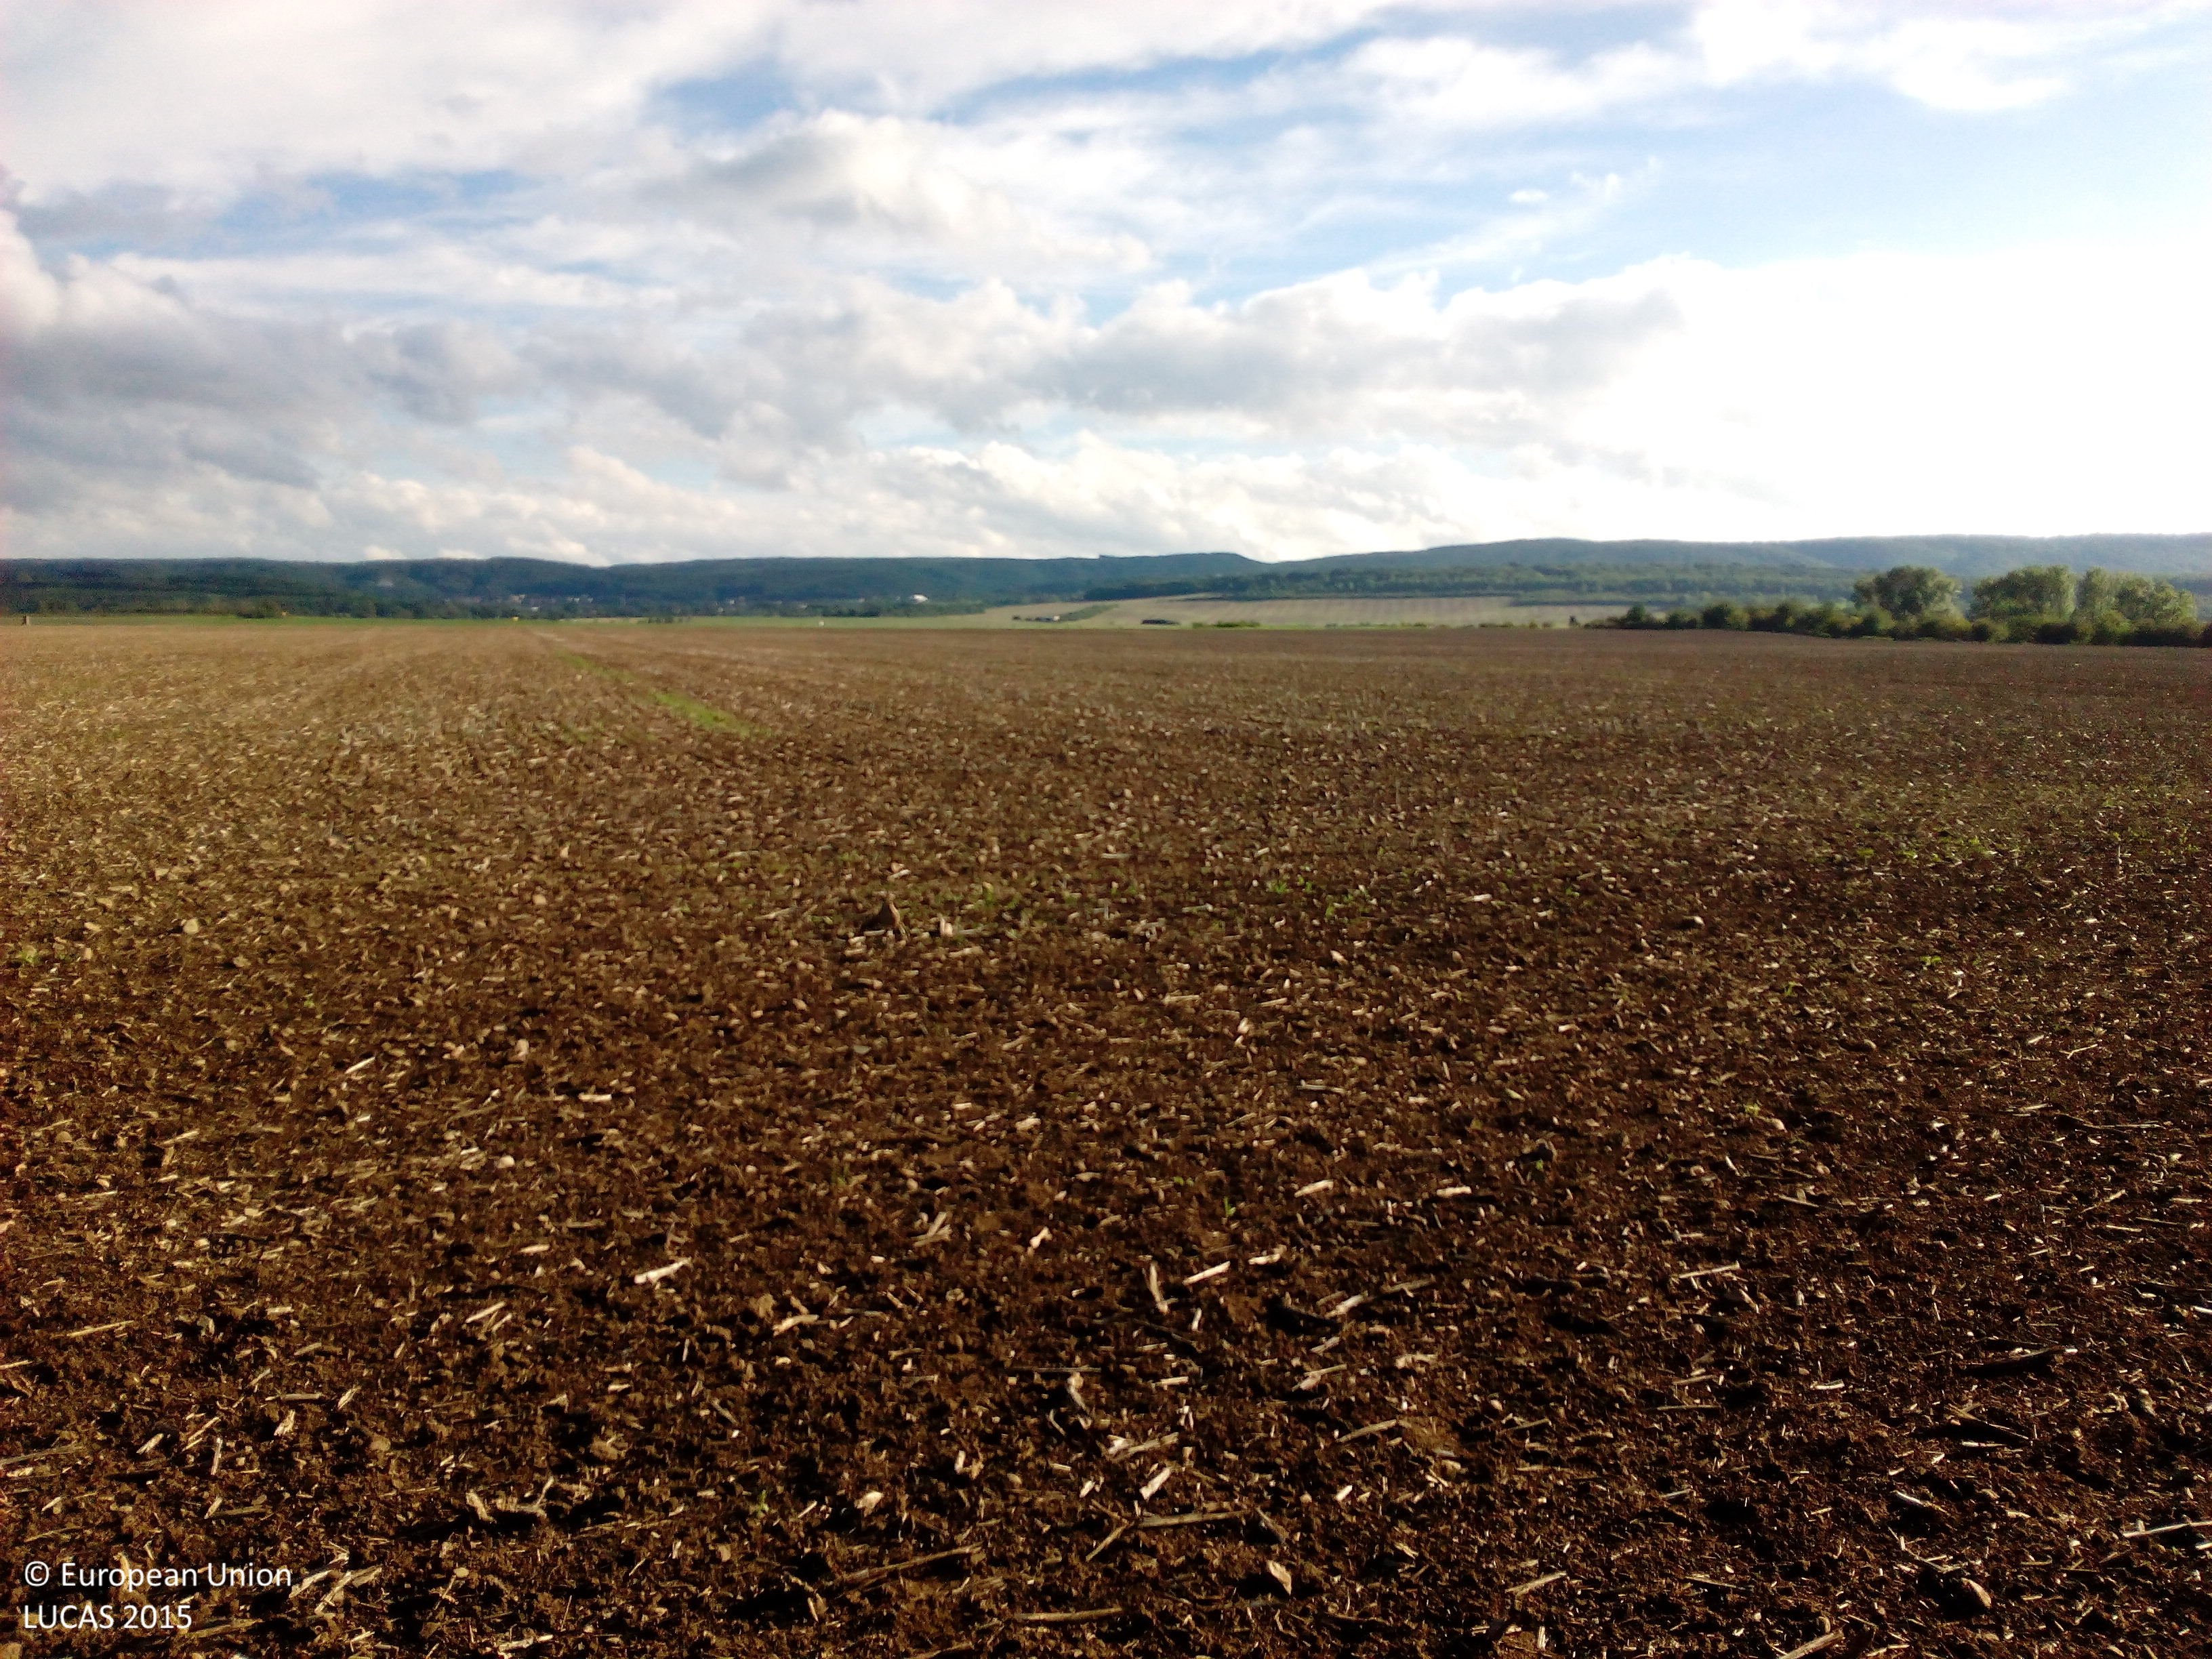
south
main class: Woodland
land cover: Broadleaved woodland
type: hemiboreal forest and nemoral coniferous forest and mixed broadleaved-coniferous forest
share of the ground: > 75 %
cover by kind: broadleaved forest trees 80 %, shrubs 10 %, herbaceous plants 10 %
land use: Forestry
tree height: > 5 m
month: September
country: DE
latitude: 51.7610
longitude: 11.1153
